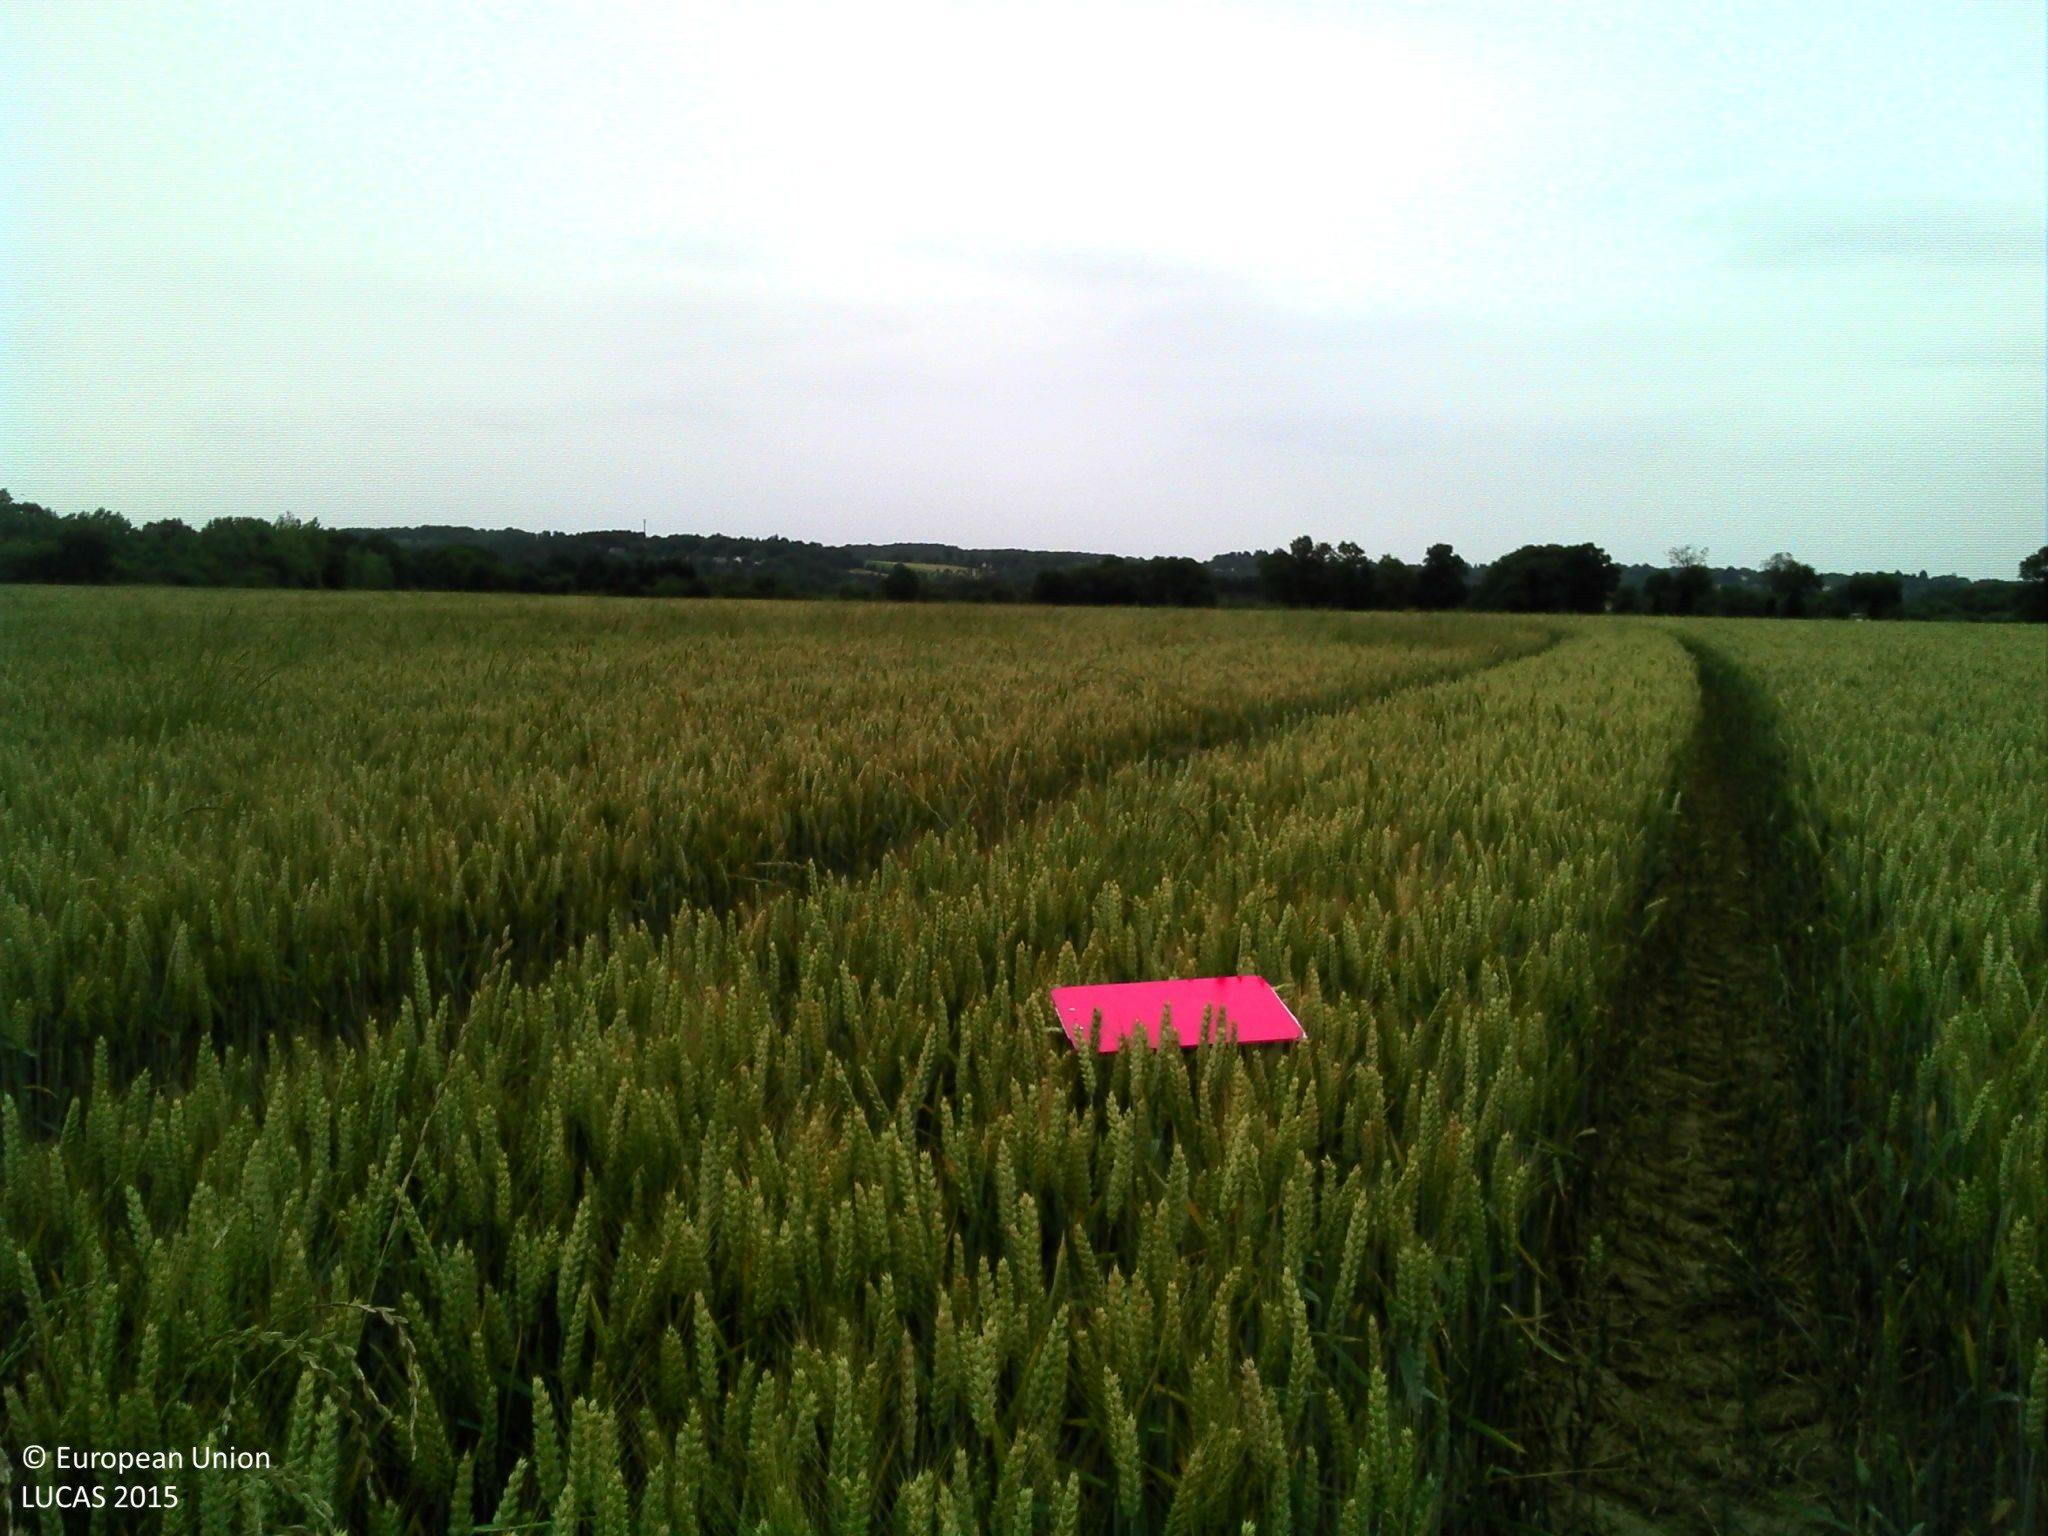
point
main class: Cropland
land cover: Common wheat
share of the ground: > 75 %
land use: Agriculture (excluding fallow land and kitchen gardens)
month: June
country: FR
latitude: 47.9432
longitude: -1.8715
